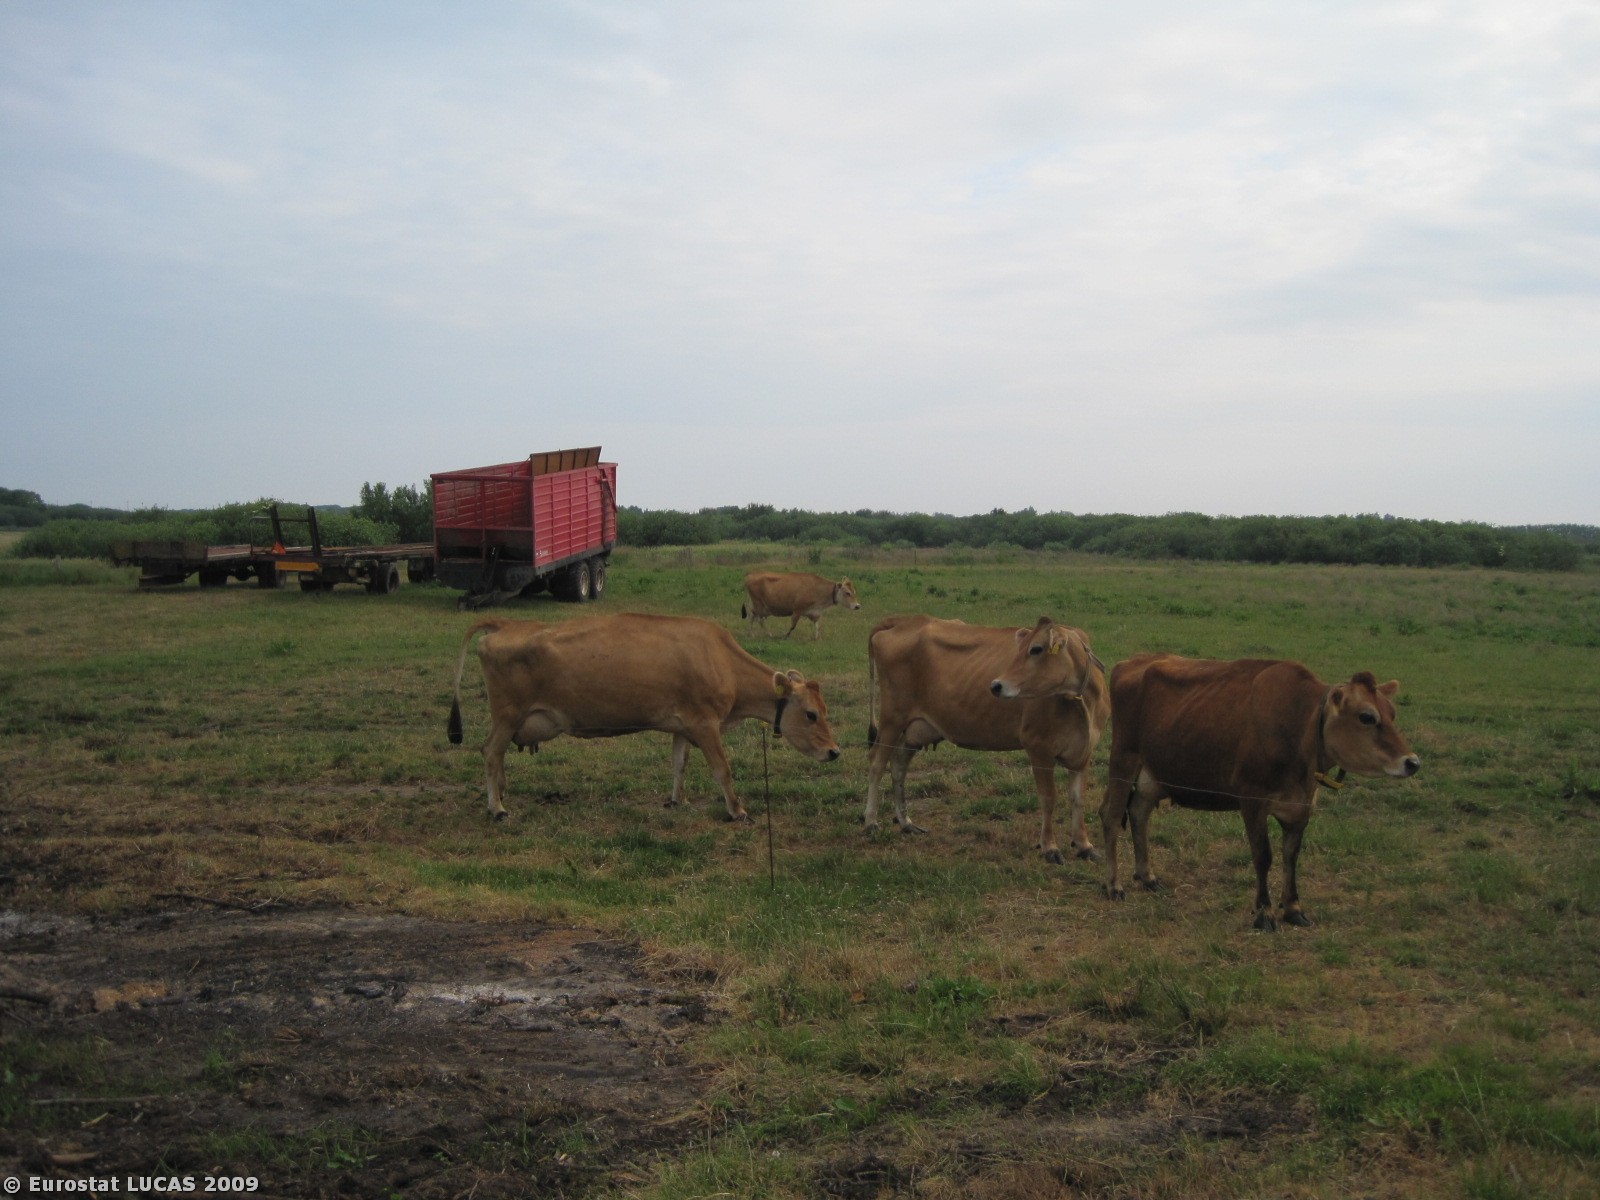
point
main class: Grassland
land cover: Grassland without tree/shrub cover
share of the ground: > 75 %
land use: Agriculture (excluding fallow land and kitchen gardens)
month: June
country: DK
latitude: 56.5385
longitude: 8.4895
